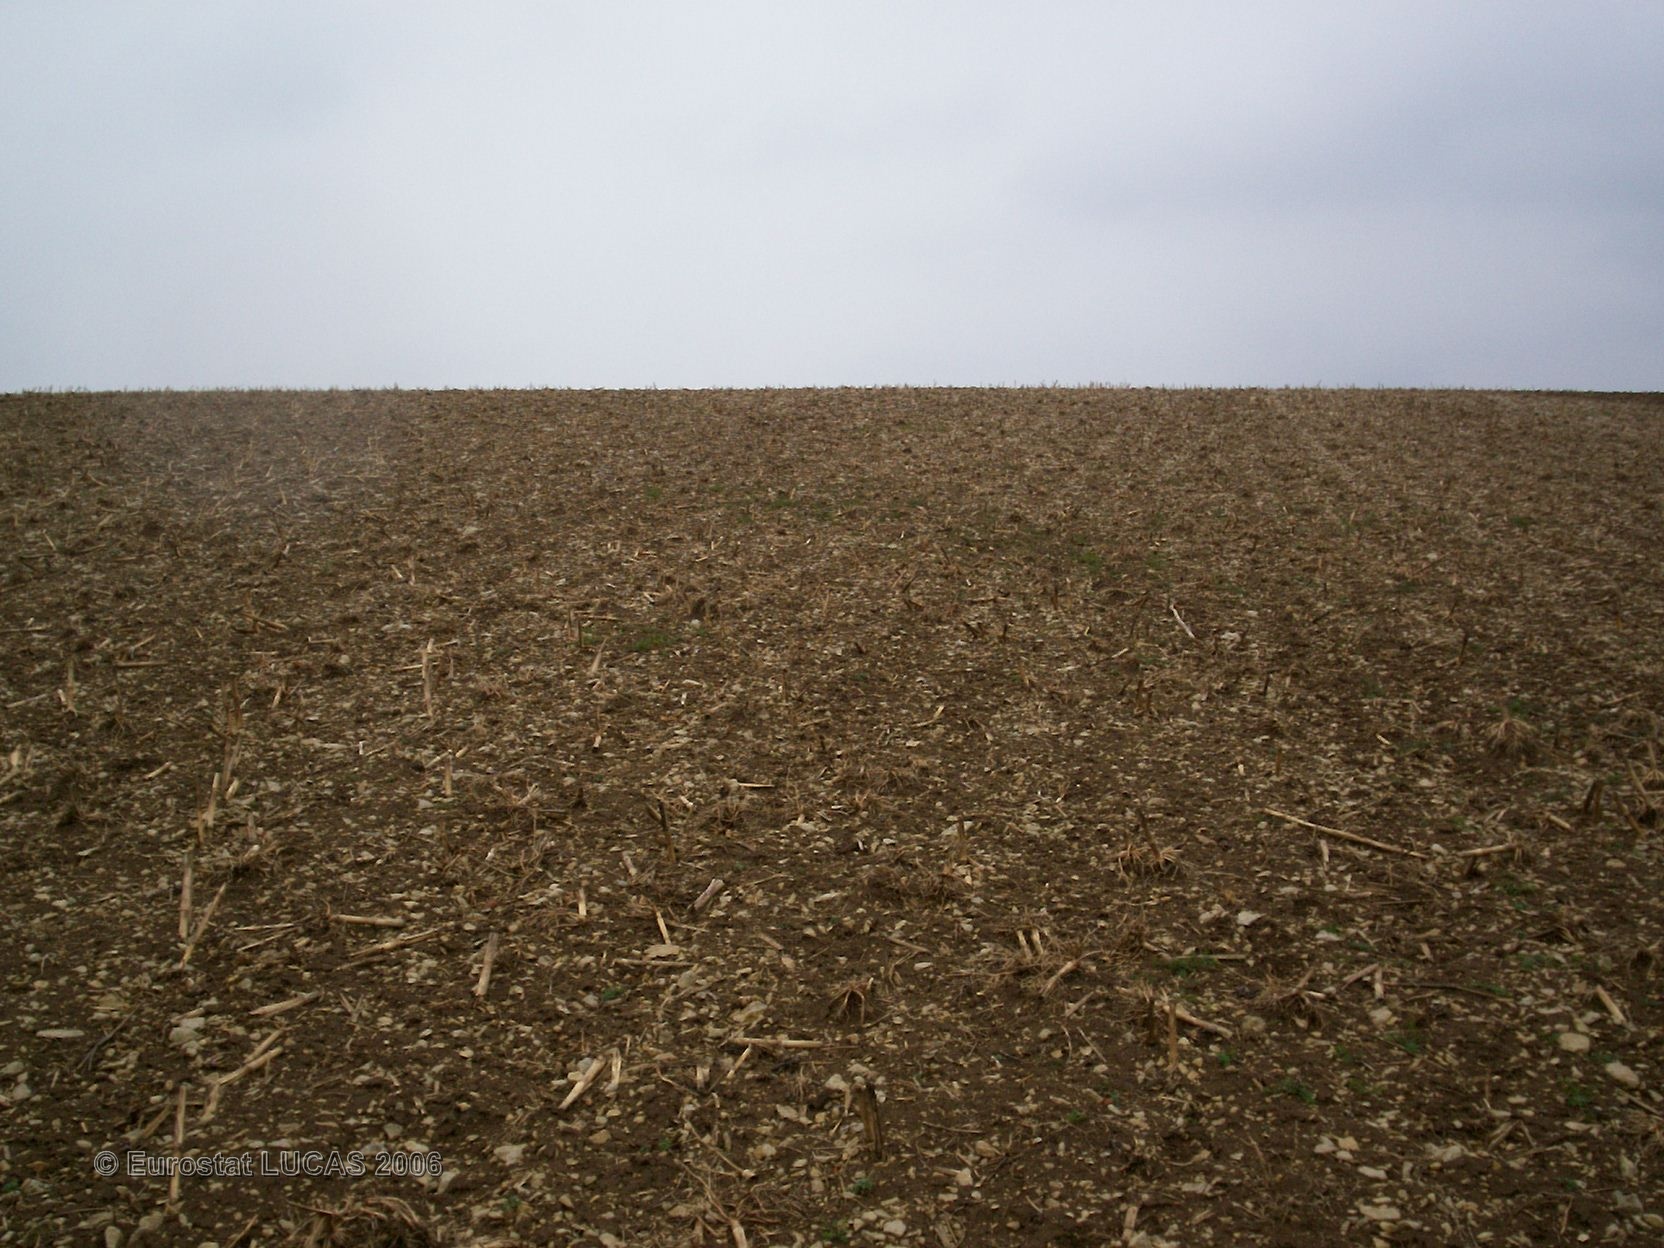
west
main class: Cropland
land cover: Maize
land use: Agriculture (excluding fallow land and kitchen gardens)
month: April
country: FR
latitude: 48.2316
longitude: 4.8962
